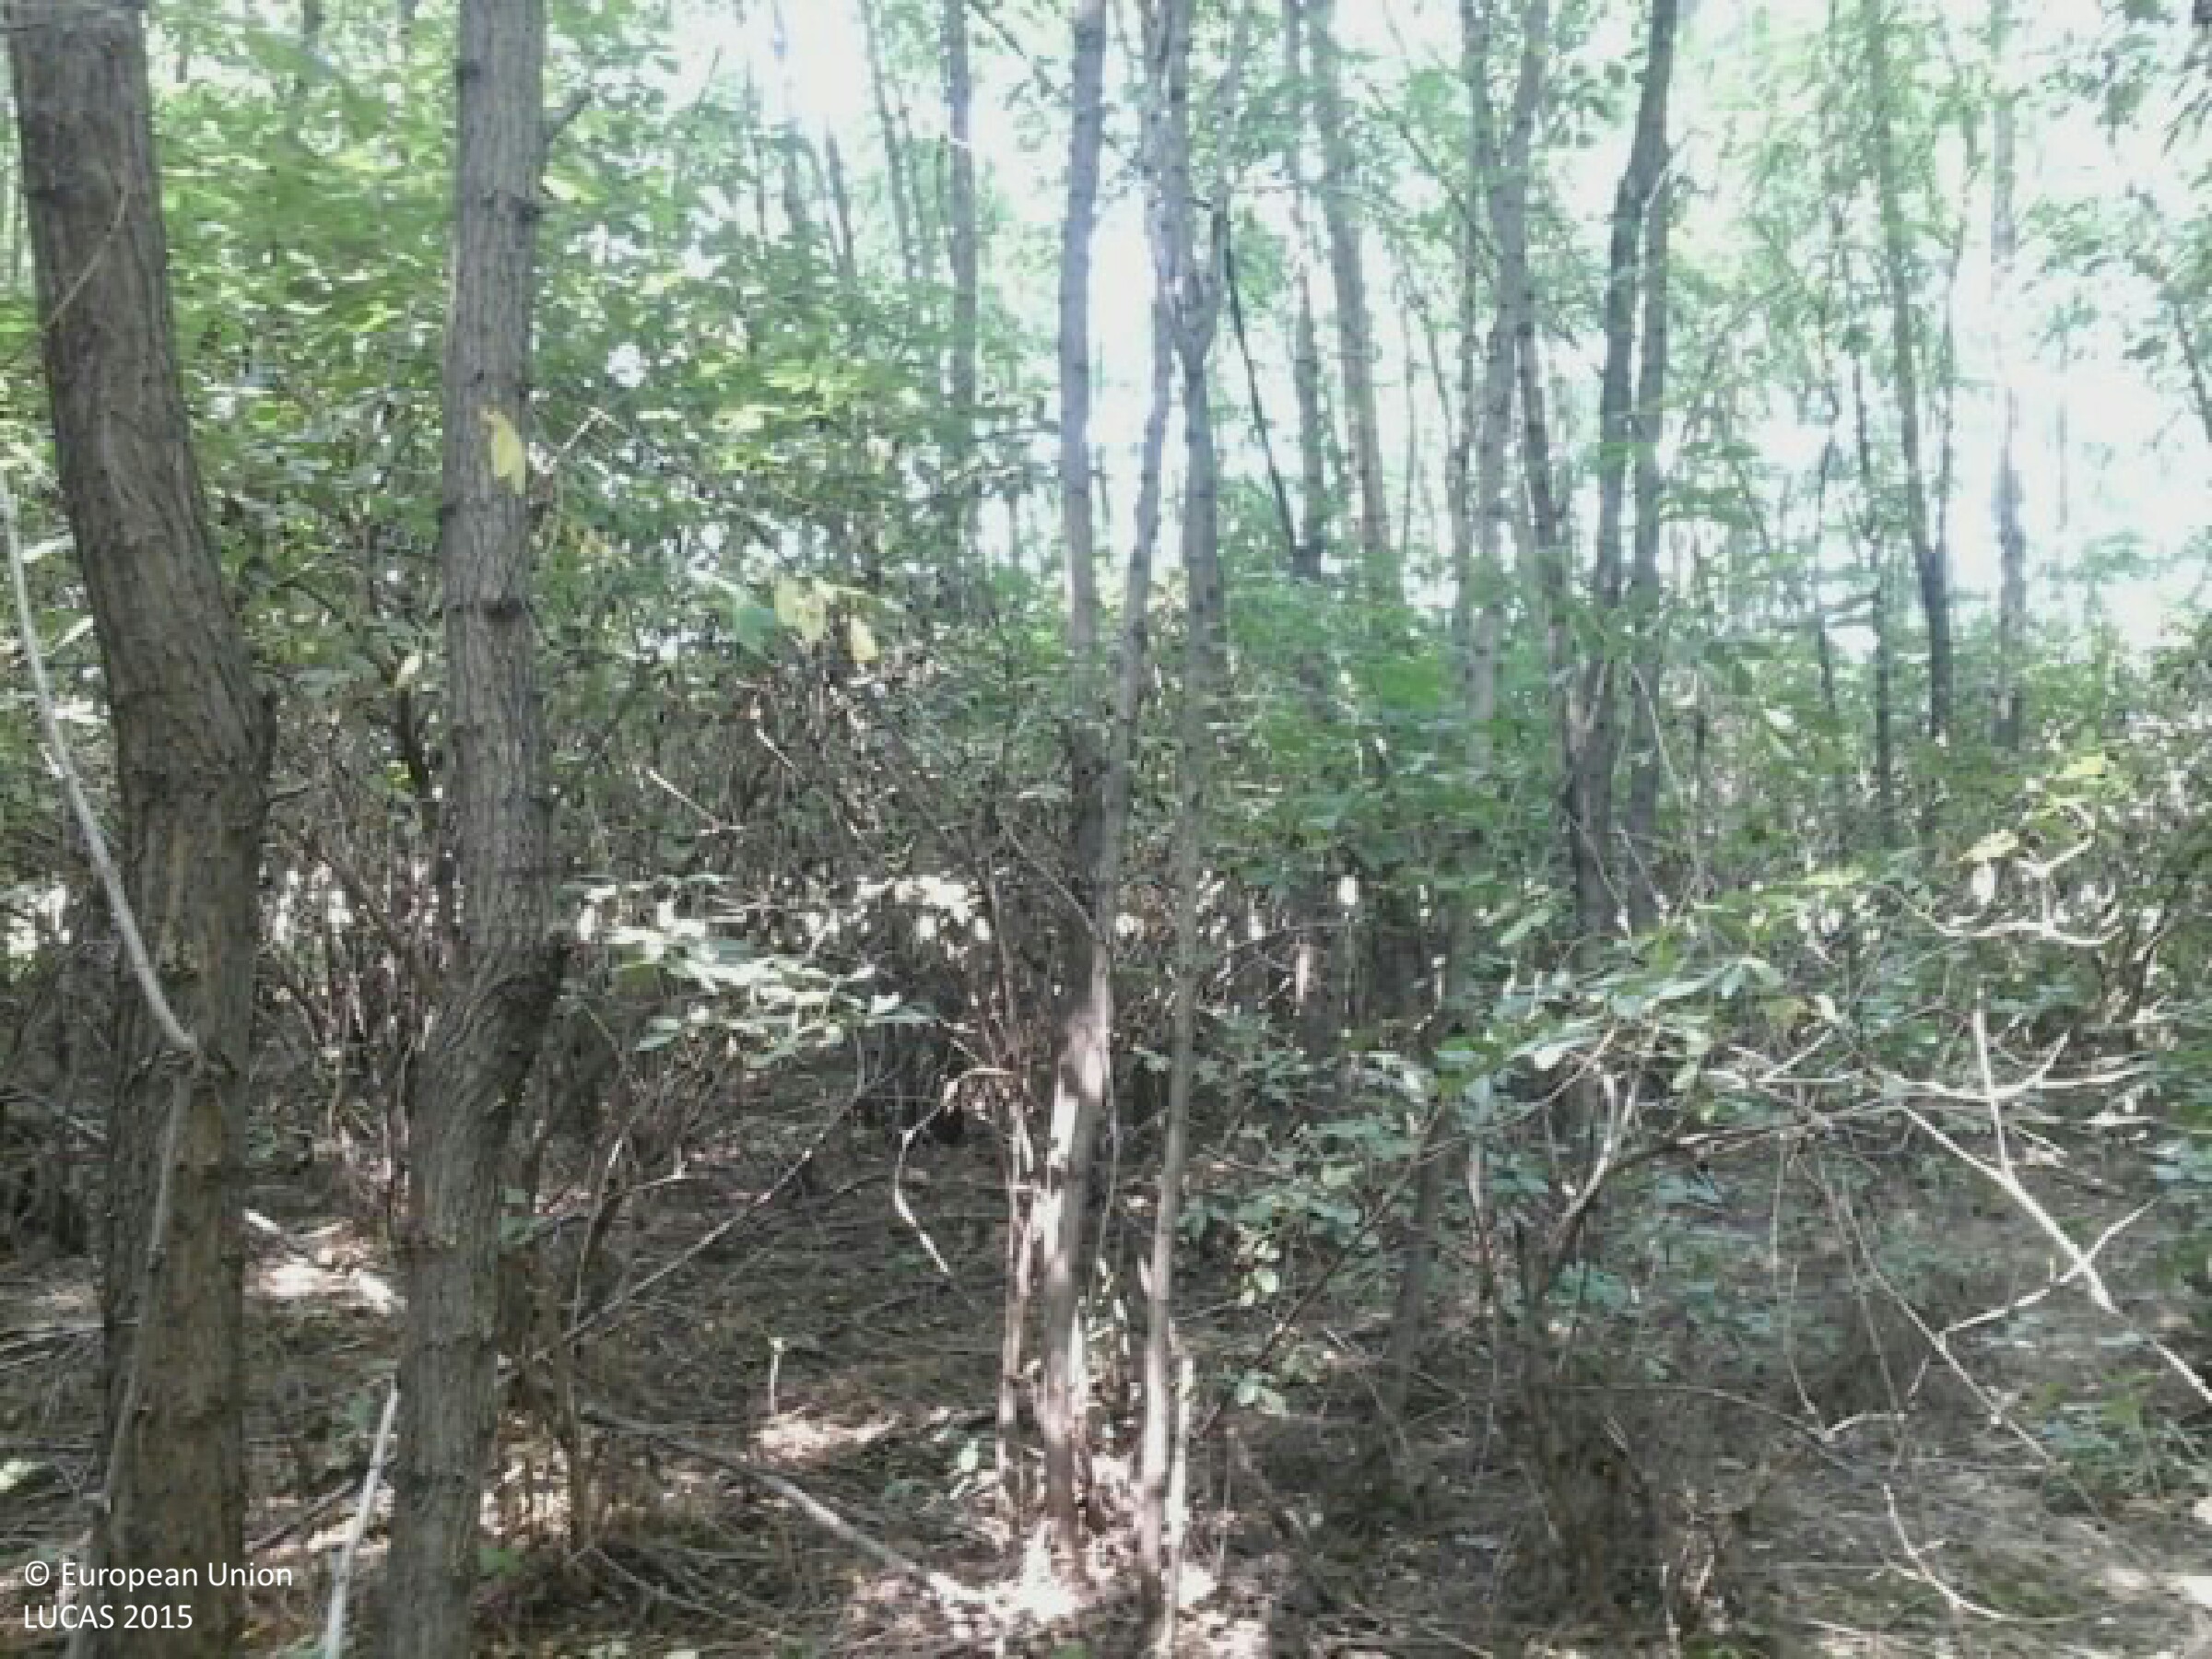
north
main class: Woodland
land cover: Broadleaved woodland
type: exotic forest
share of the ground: > 75 %
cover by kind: broadleaved forest trees 90 %, shrubs 5 %, herbaceous plants 5 %
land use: Forestry
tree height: > 5 m
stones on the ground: < 10 %
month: August
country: HU
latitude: 46.4145
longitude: 17.9821
